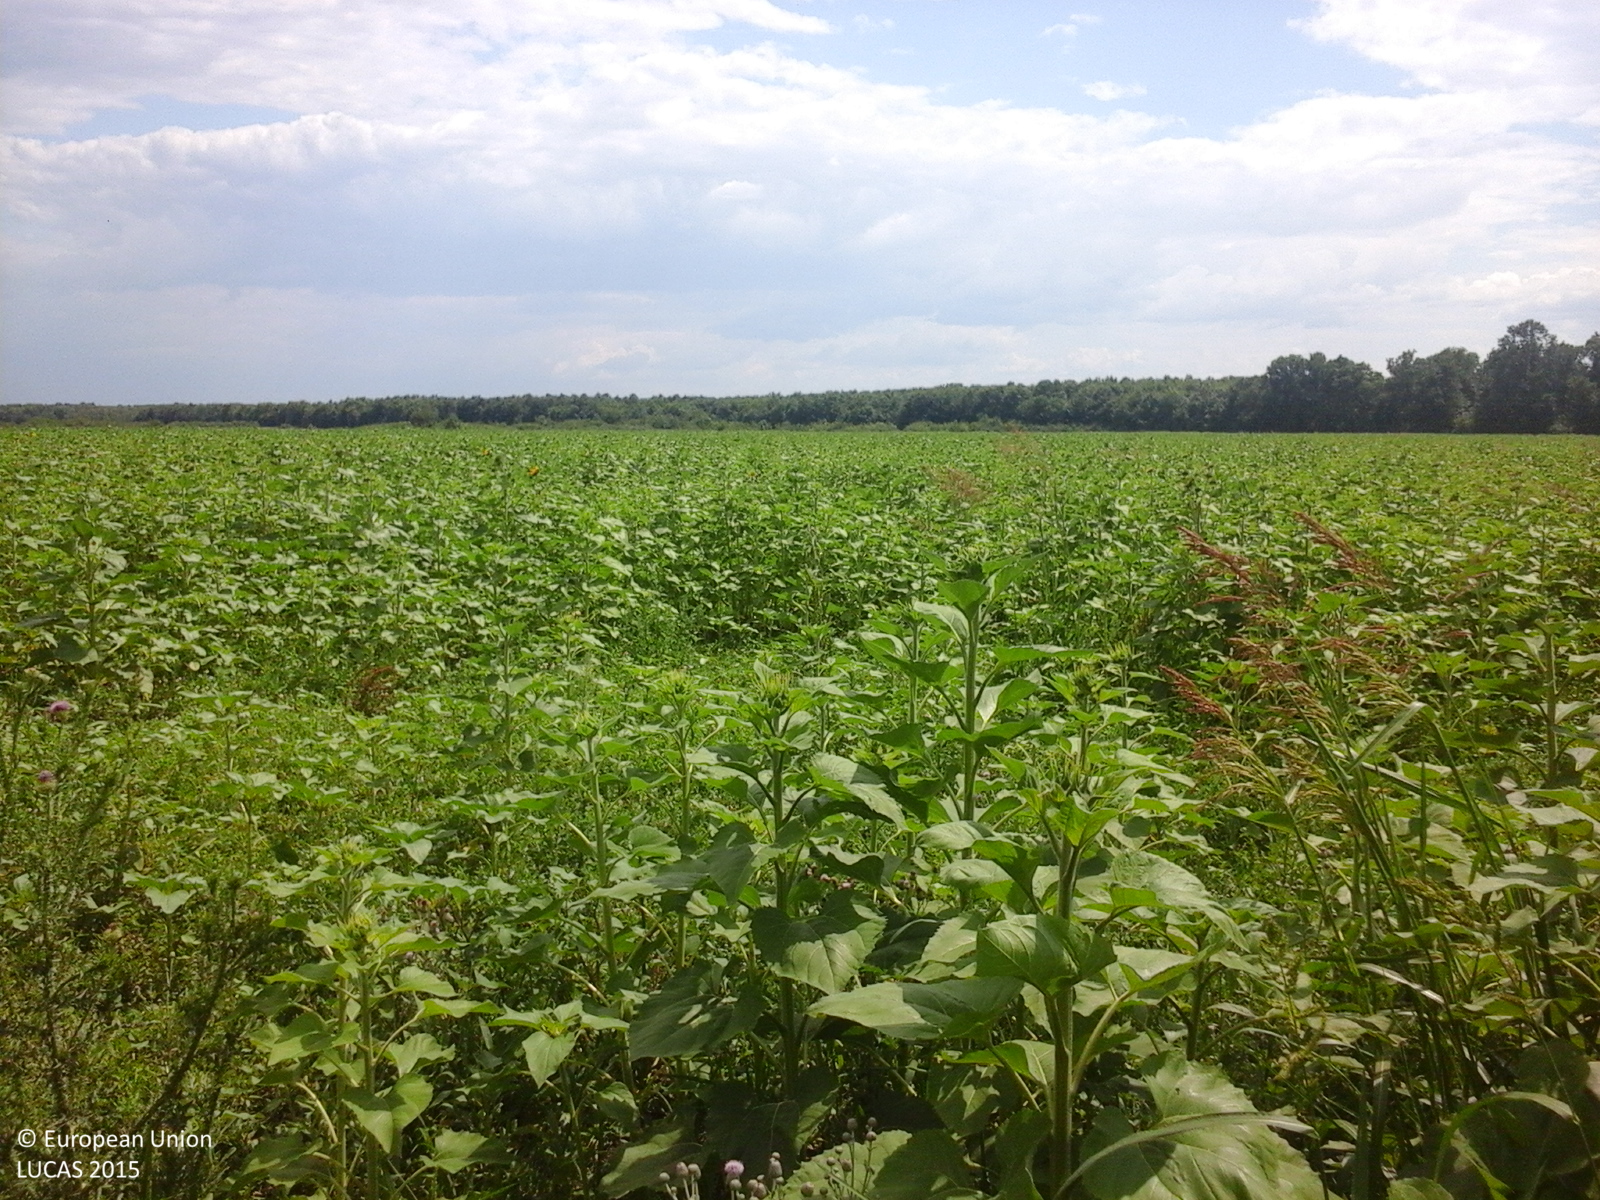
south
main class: Cropland
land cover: Sunflower
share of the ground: > 75 %
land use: Agriculture (excluding fallow land and kitchen gardens)
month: July
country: RO
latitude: 44.0213
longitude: 24.6278
